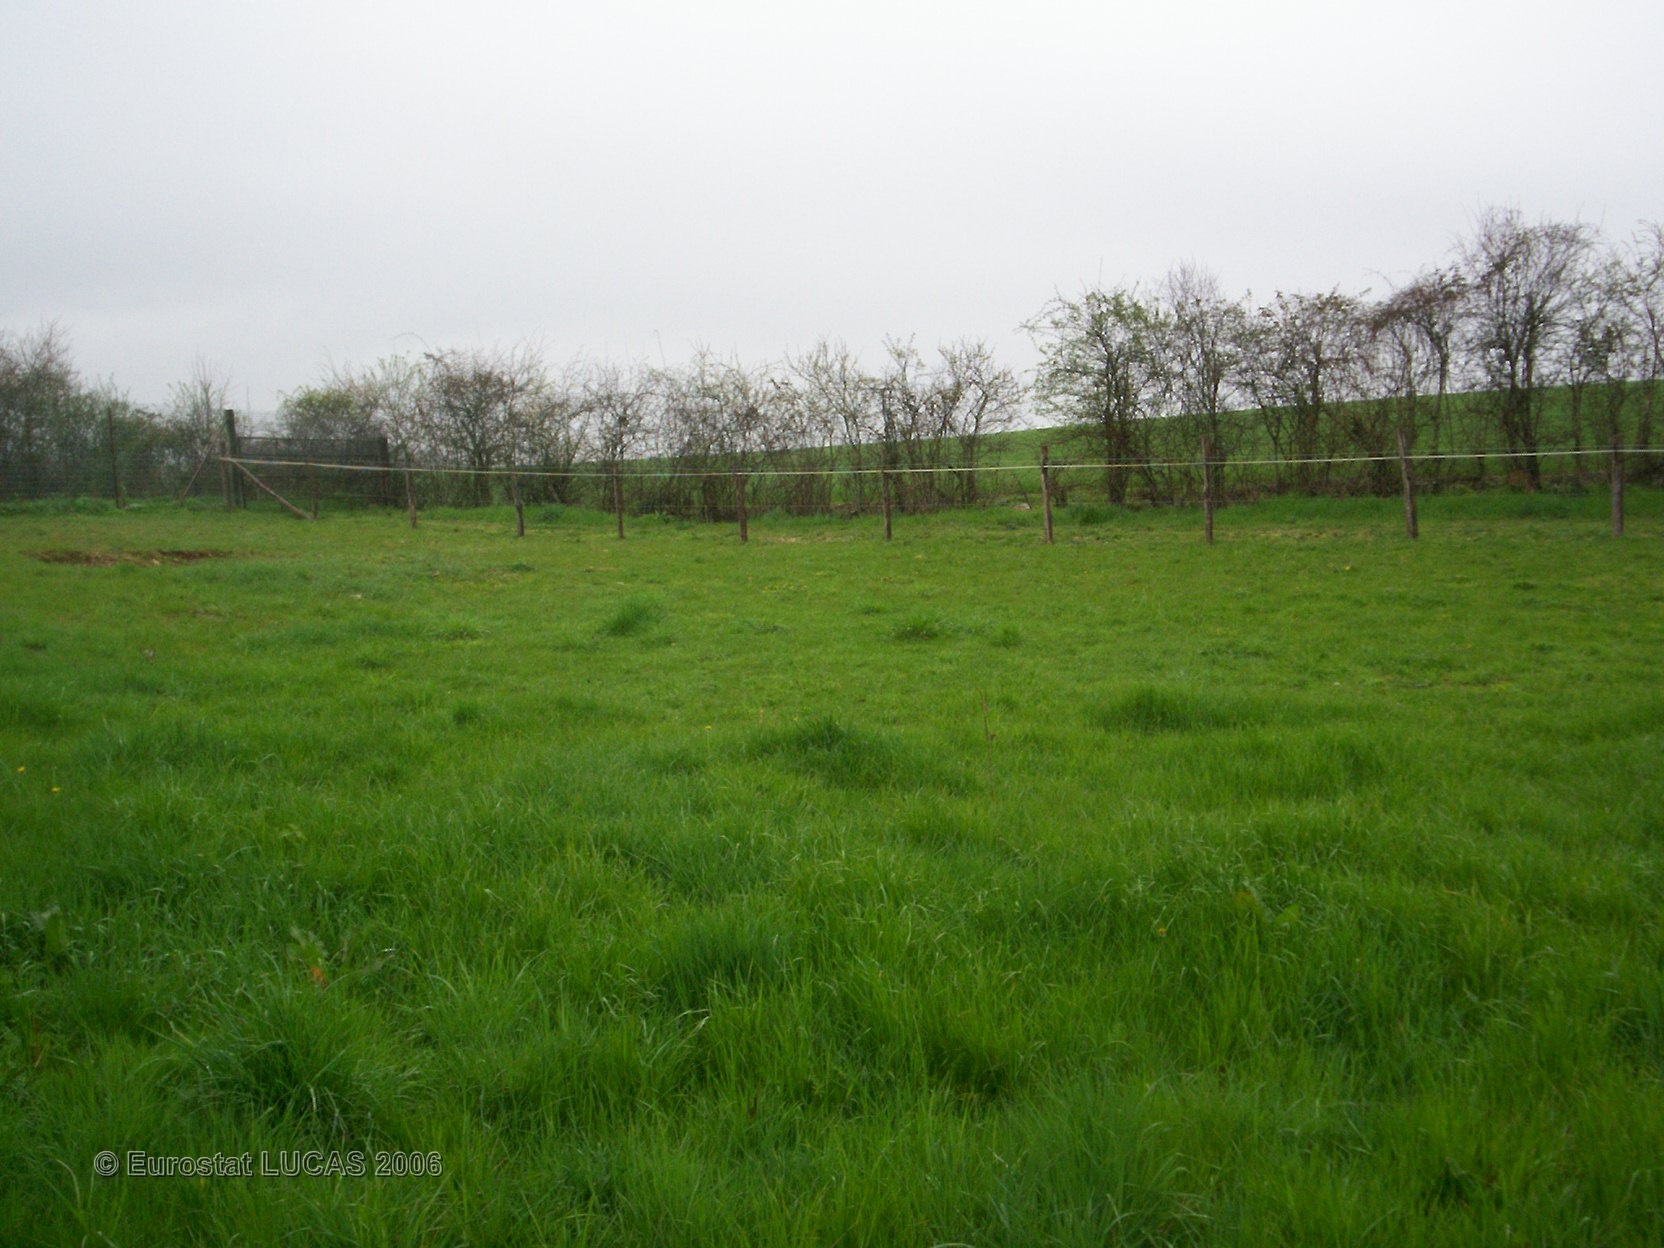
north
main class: Grassland
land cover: Grassland without tree/shrub cover
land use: Agriculture (excluding fallow land and kitchen gardens)
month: April
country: FR
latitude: 48.3575
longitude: 0.1064
